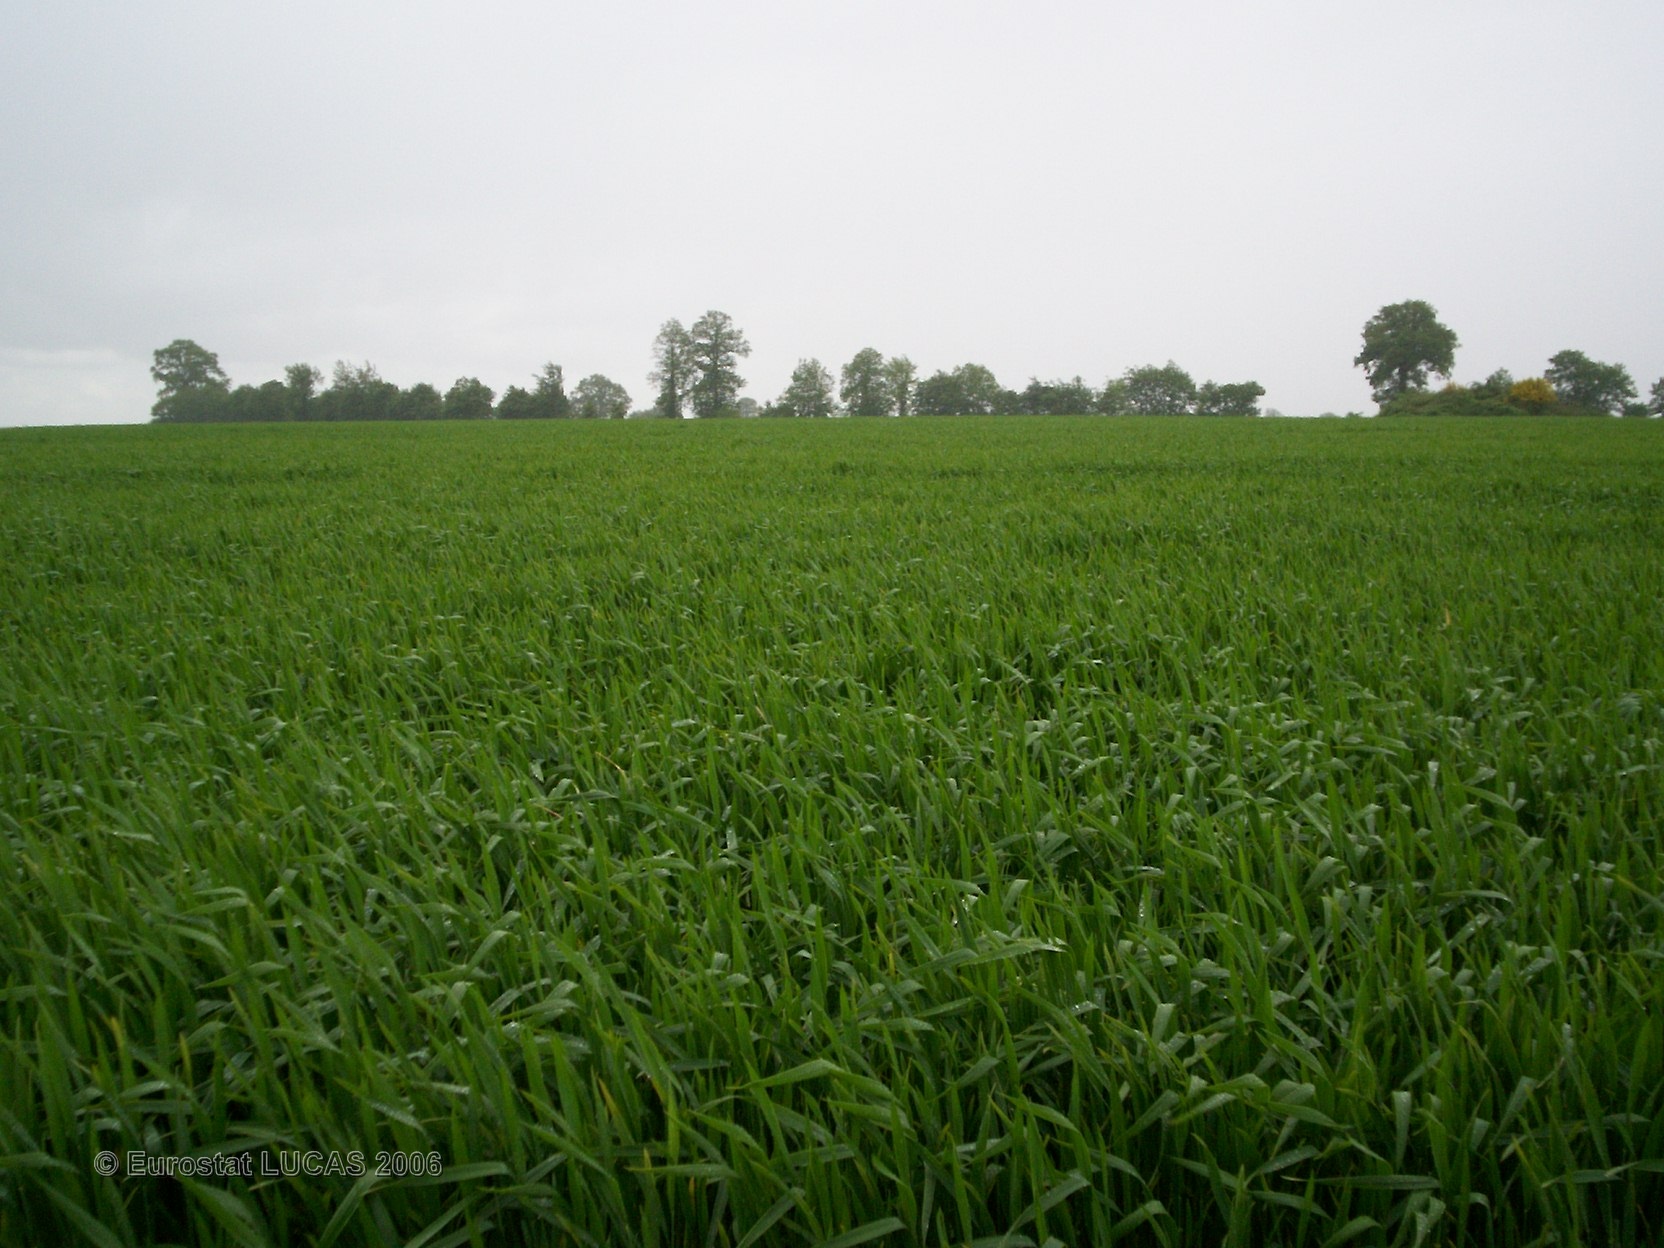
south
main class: Cropland
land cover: Common wheat
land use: Agriculture (excluding fallow land and kitchen gardens)
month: May
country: FR
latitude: 48.5339
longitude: -0.7227
